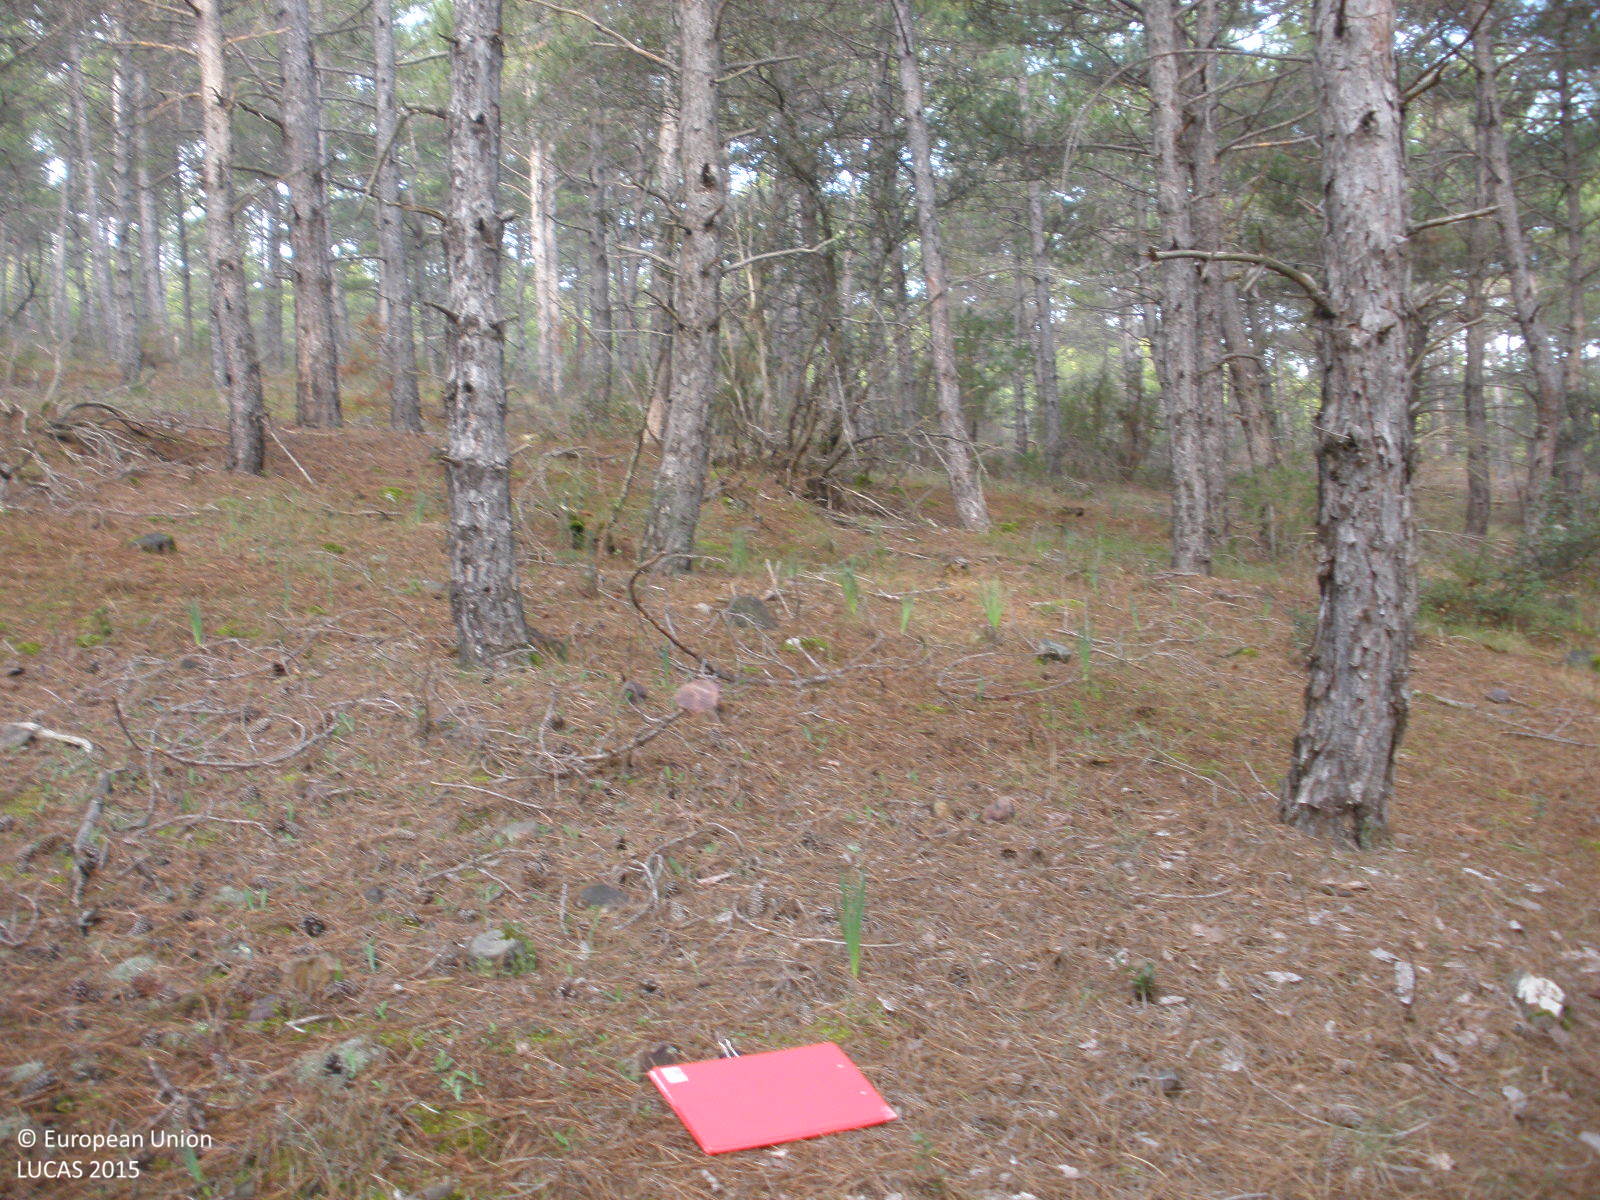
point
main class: Woodland
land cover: Pine dominated coniferous woodland
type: coniferous forest of the mediterranean region
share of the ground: > 75 %
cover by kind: coniferous forest trees 90 %, consolidated bare surface 10 %
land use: Forestry
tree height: < 5 m
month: April
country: ES
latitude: 41.1425
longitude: -1.1589
